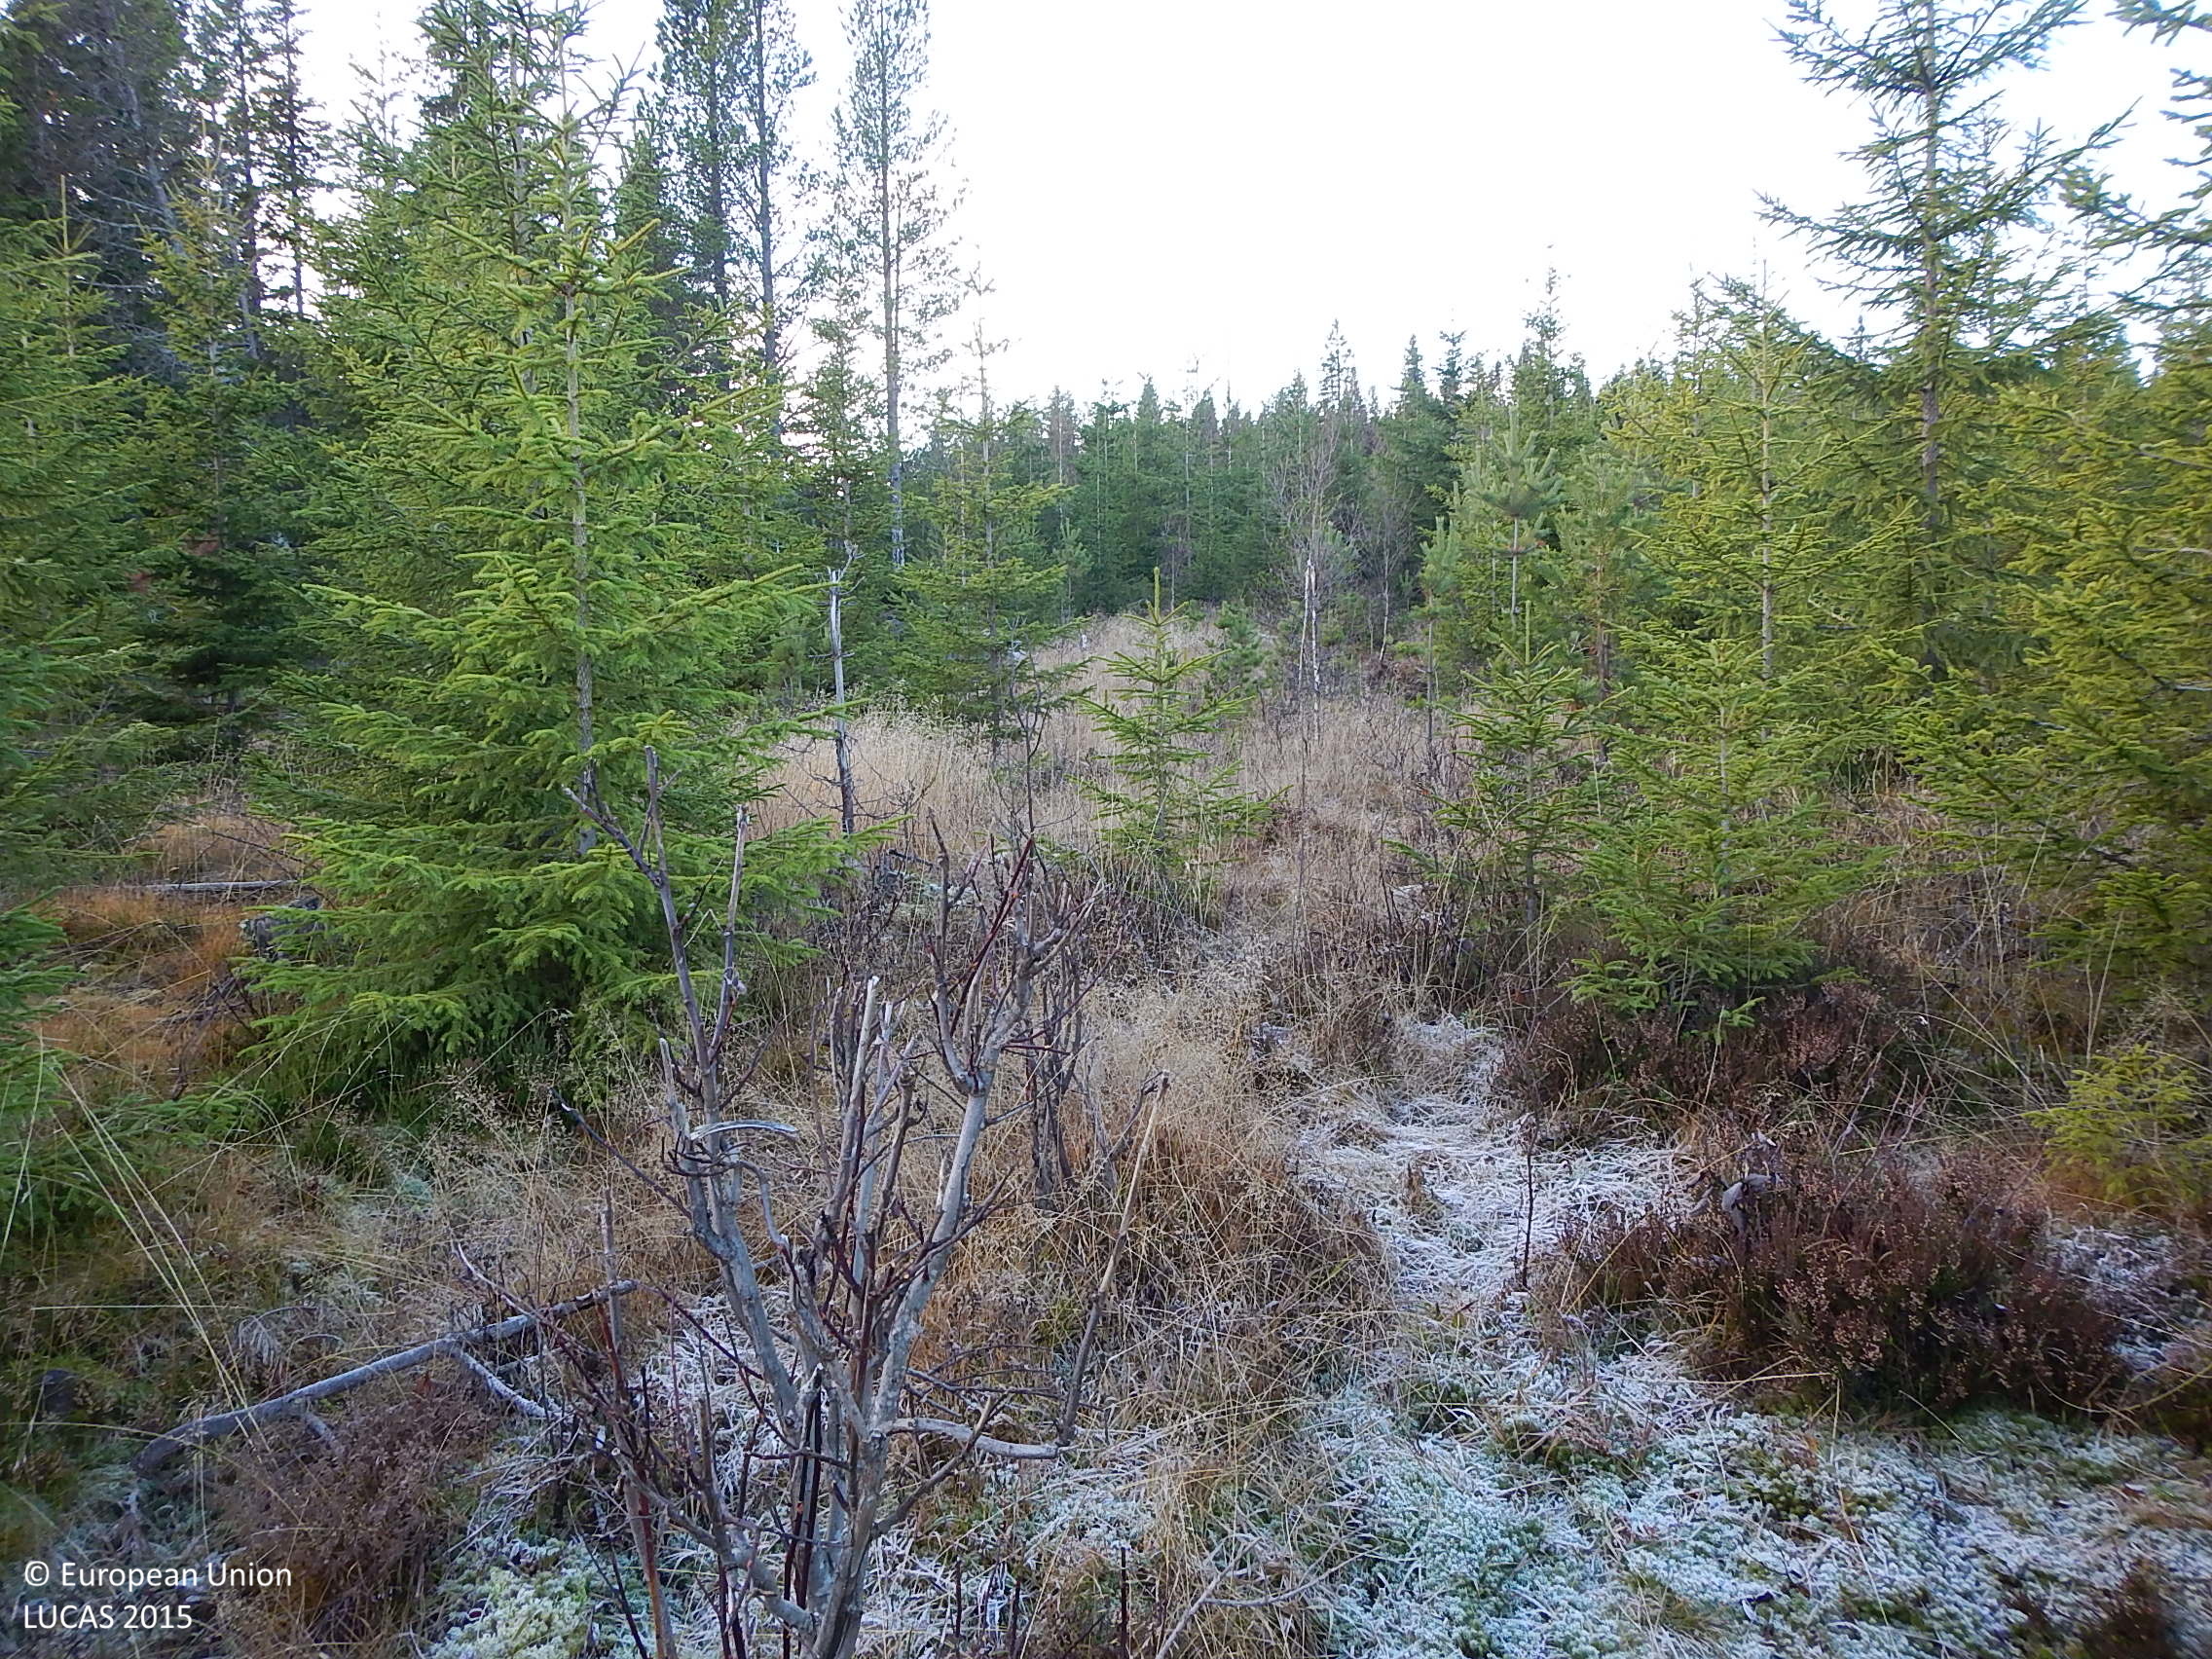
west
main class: Woodland
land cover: Spruce dominated coniferous woodland
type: boreal forest
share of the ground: 25 - 50 %
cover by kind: coniferous forest trees 40 %, shrubs 25 %, herbaceous plants 25 %, lichens and mosses 10 %
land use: Forestry
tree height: < 5 m
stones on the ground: < 10 %
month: November
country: SE
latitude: 61.5649
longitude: 16.1397
